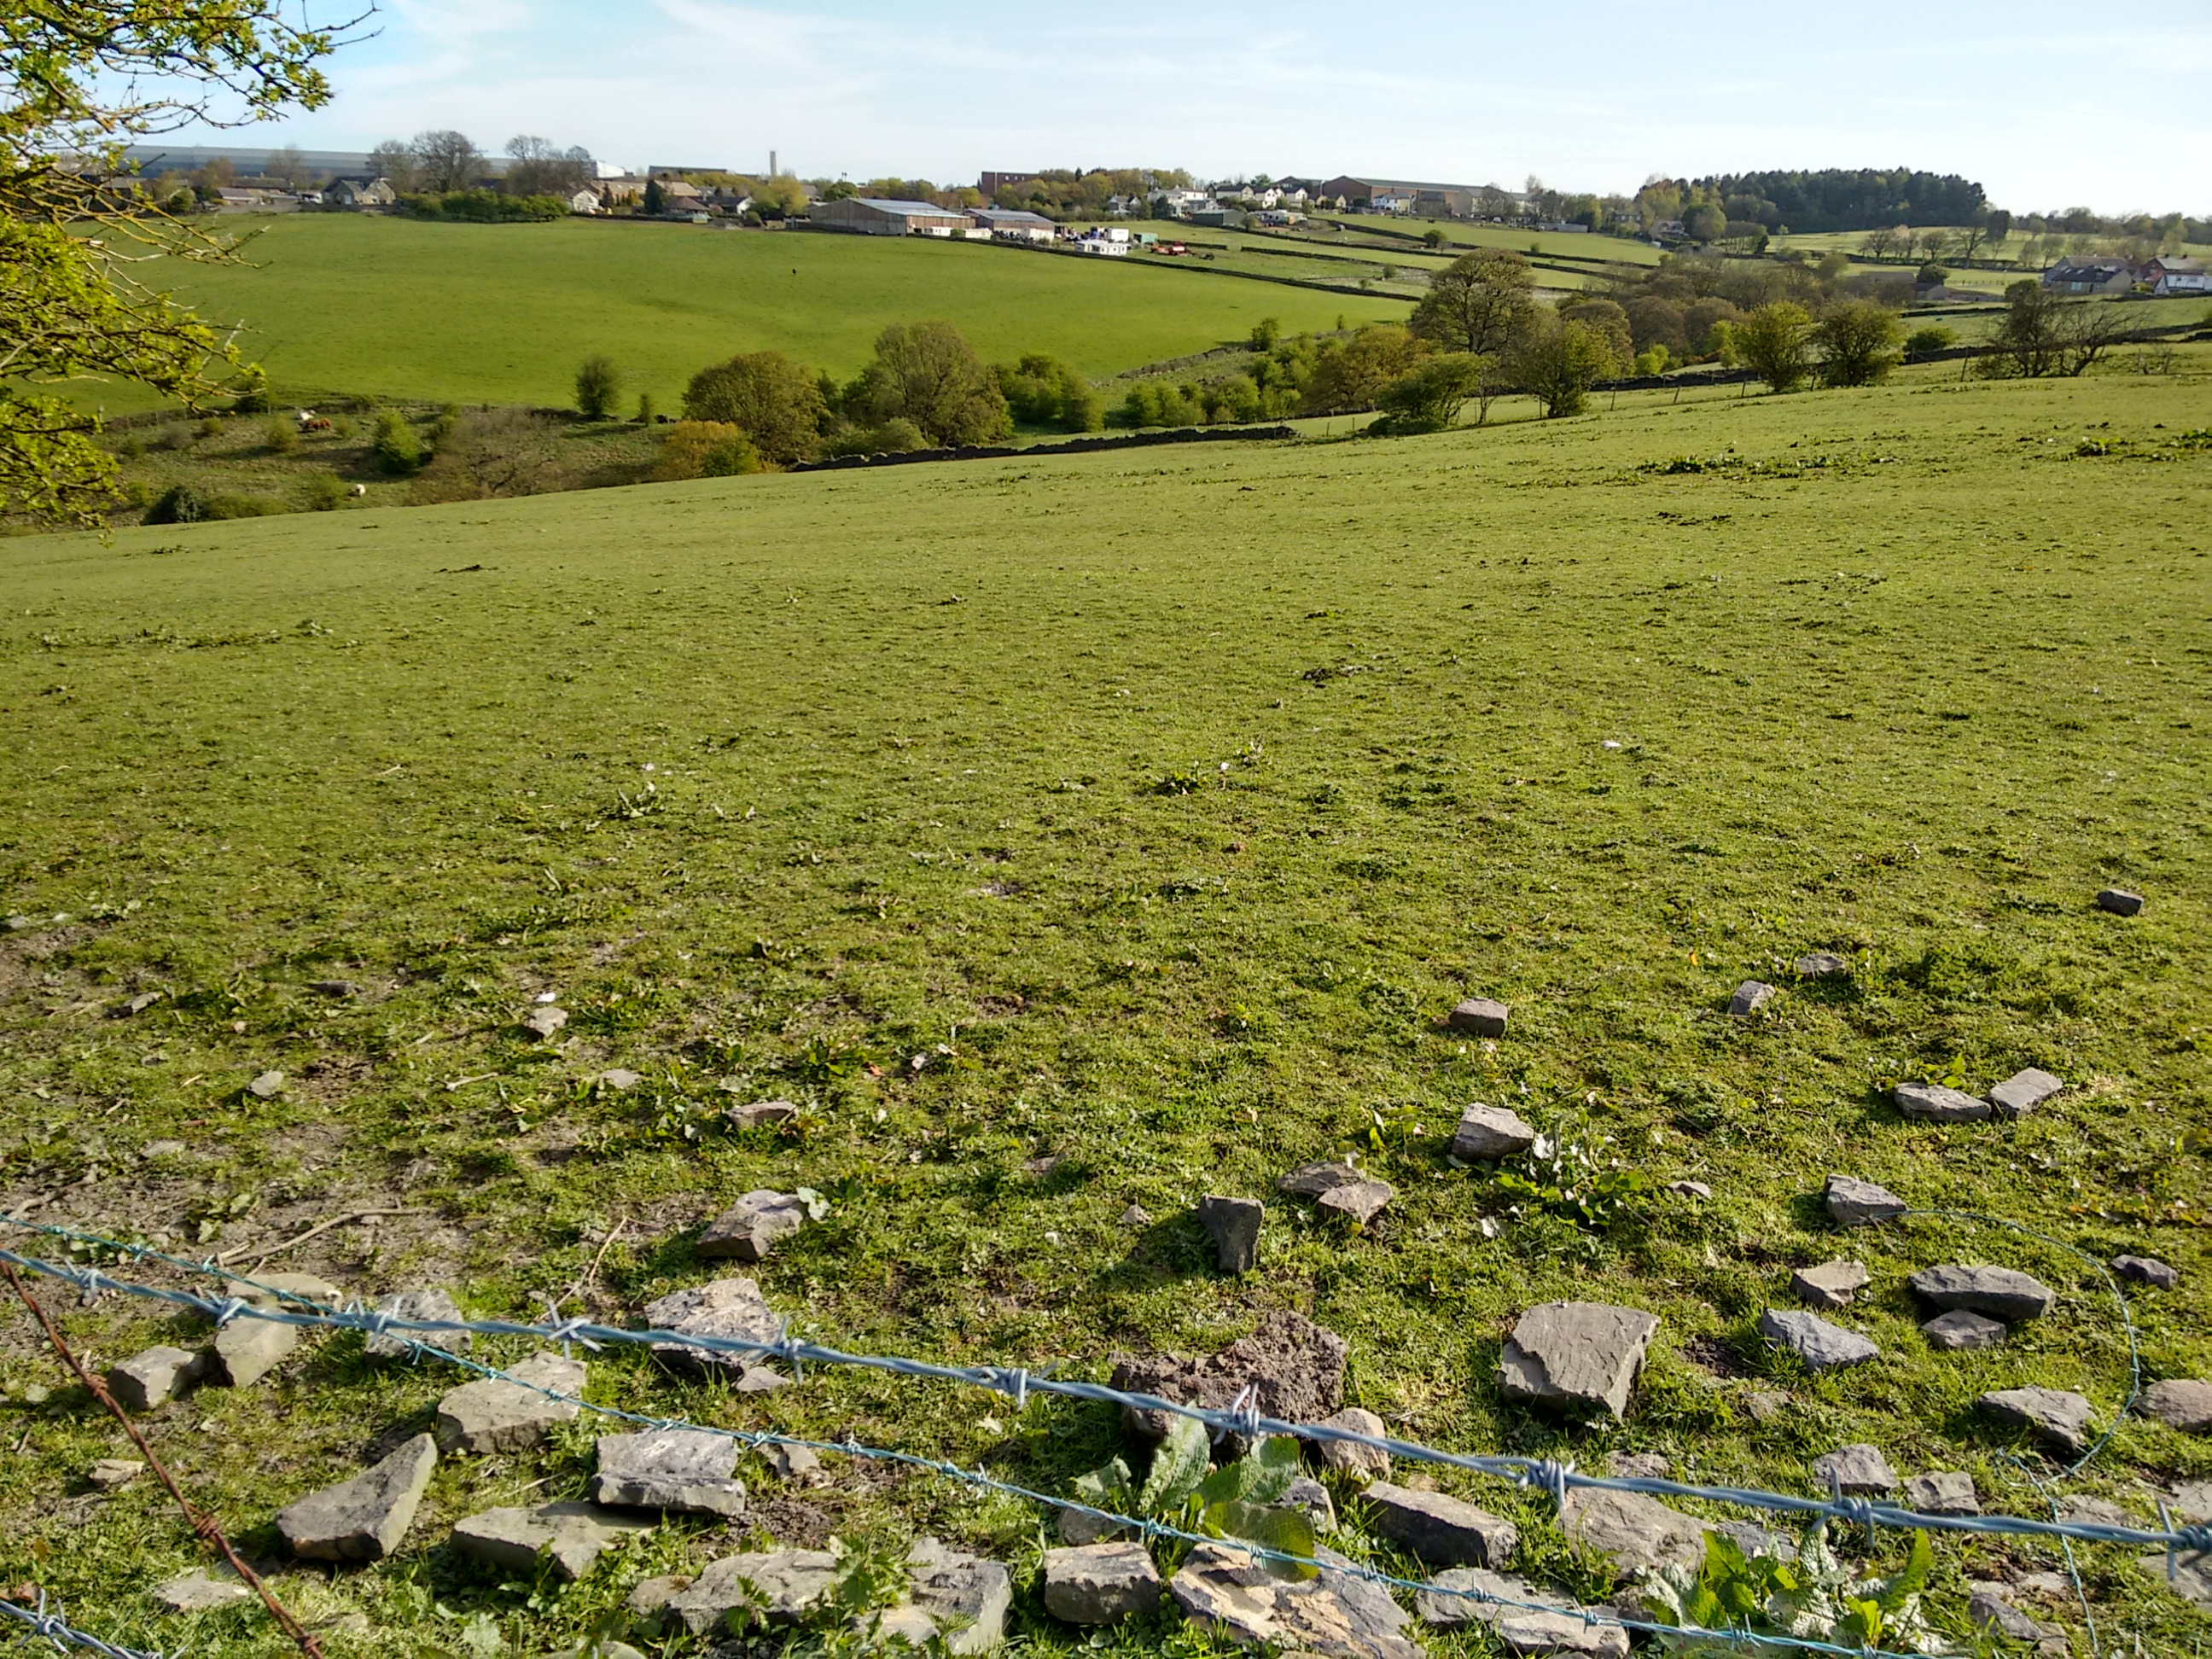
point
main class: Grassland
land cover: Grassland without tree/shrub cover
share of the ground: > 75 %
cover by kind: herbaceous plants 100 %
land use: Agriculture (excluding fallow land and kitchen gardens)
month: May
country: GB
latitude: 53.7578
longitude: -1.7168
